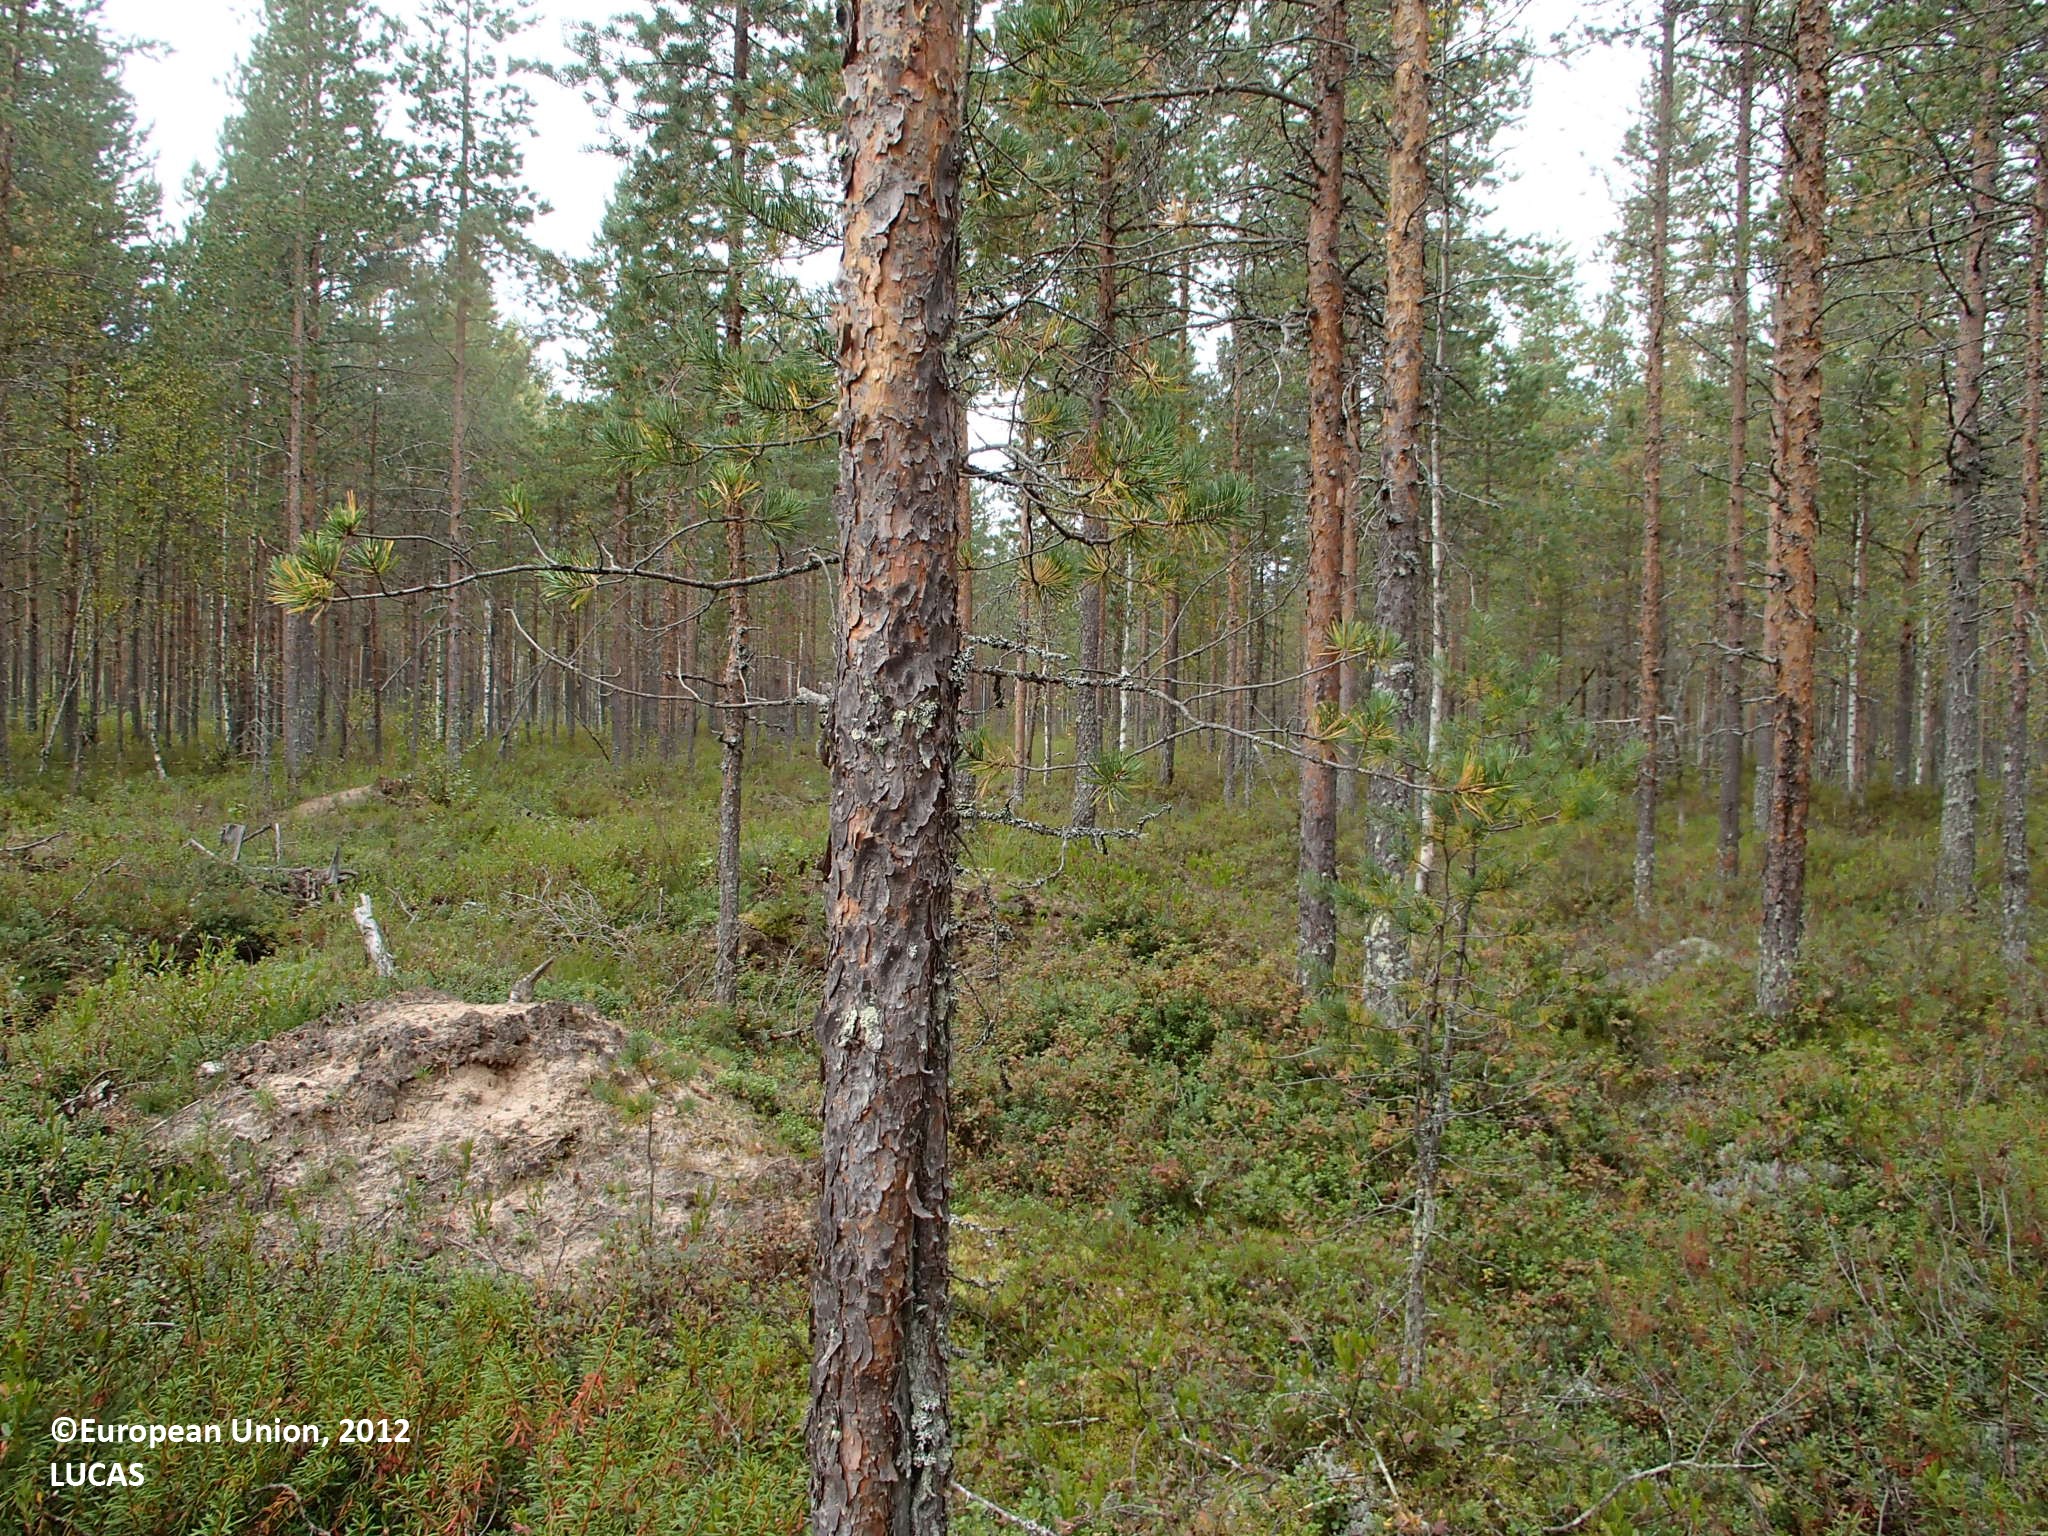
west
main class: Woodland
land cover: Pine dominated coniferous woodland
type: boreal forest
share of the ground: 50 - 75 %
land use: Forestry
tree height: > 5 m
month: September
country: FI
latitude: 63.7998
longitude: 26.0058
